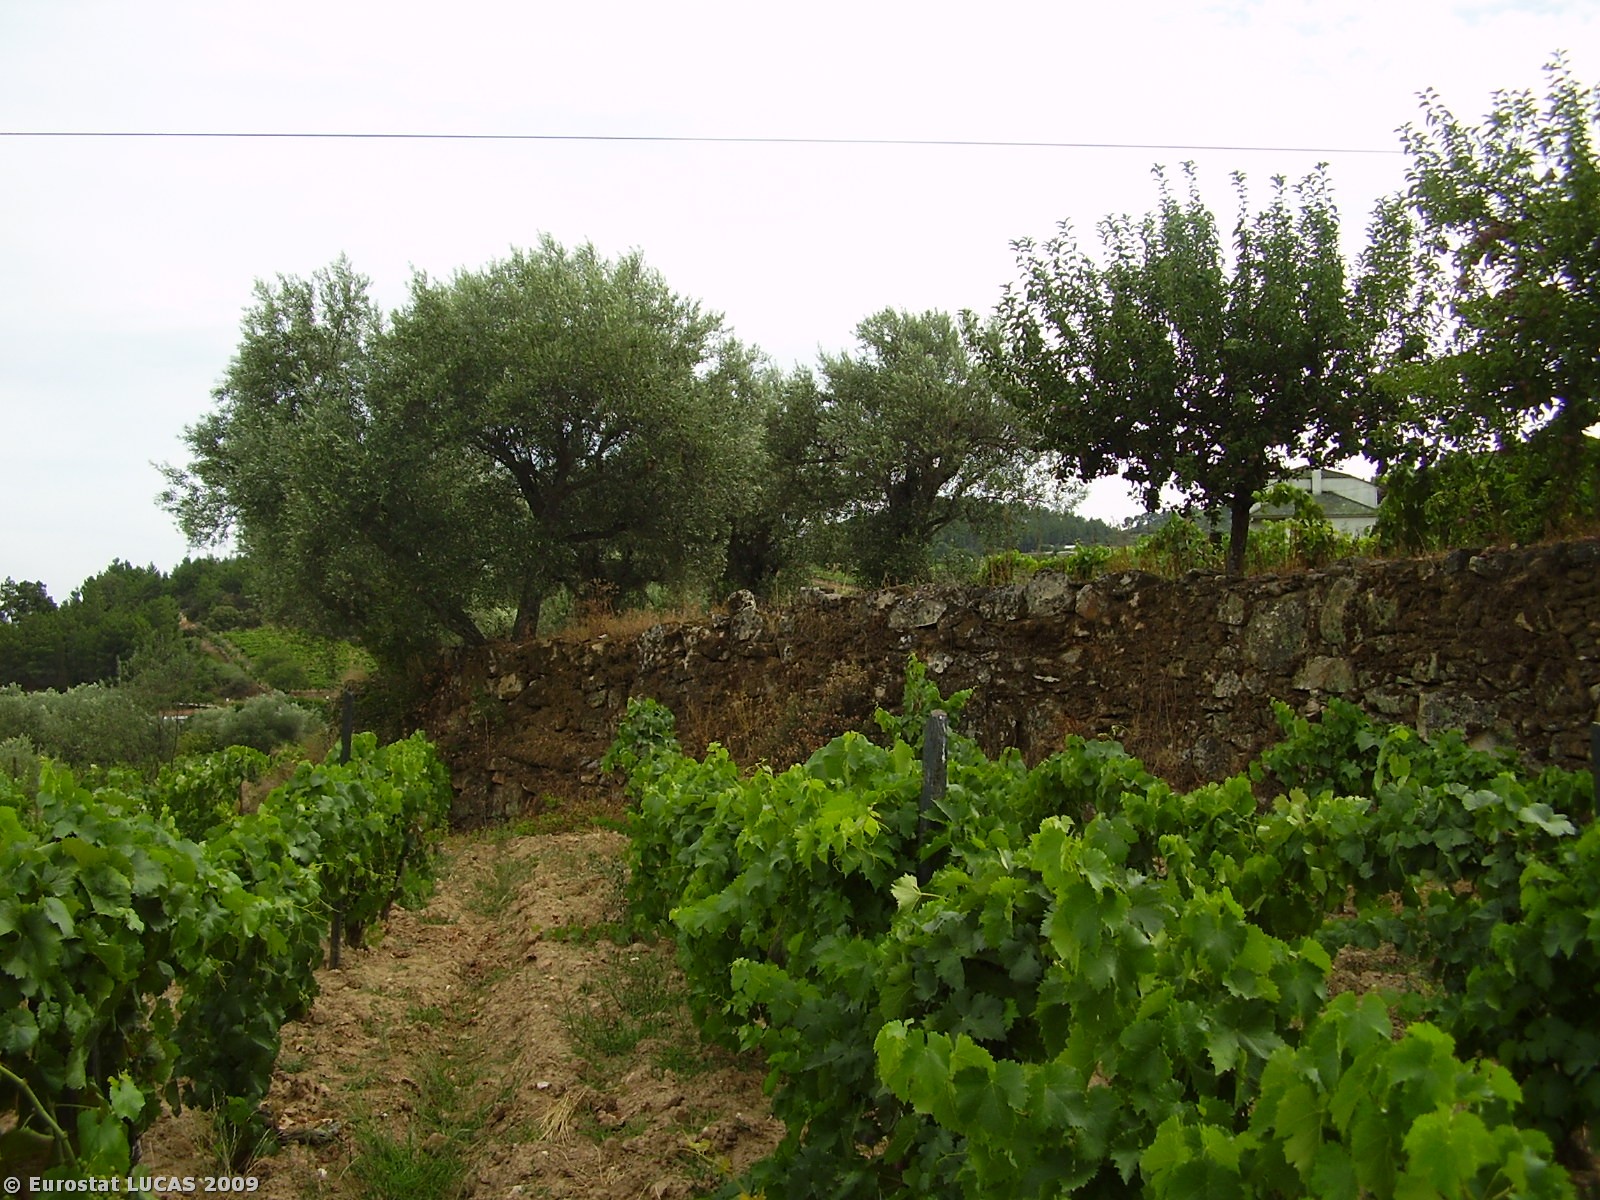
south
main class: Cropland
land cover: Vineyards
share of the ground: < 10 %
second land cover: Spontaneously vegetated surfaces
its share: < 10 %
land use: Agriculture (excluding fallow land and kitchen gardens)
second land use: Unused
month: July
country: PT
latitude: 41.2563
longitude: -7.4393
